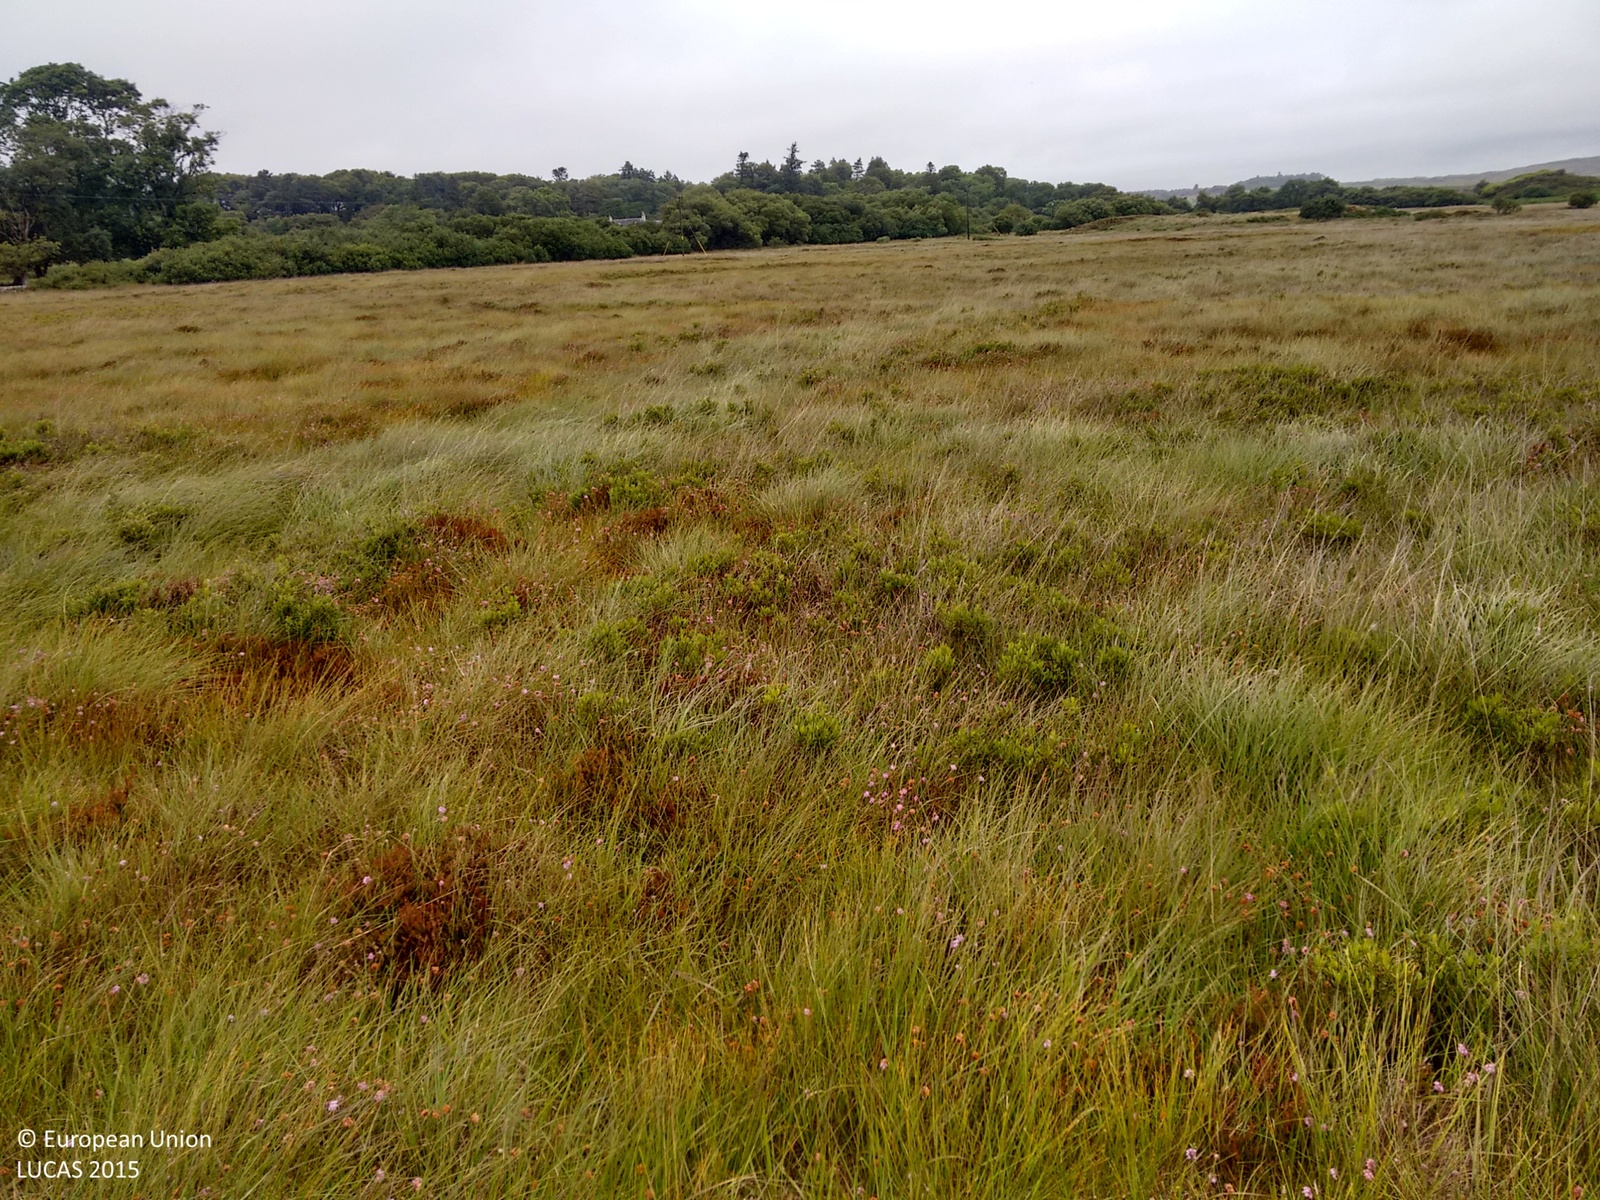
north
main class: Shrubland
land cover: Shrubland without tree cover
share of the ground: 50 - 75 %
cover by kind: shrubs 60 %, herbaceous plants 40 %
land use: Semi-natural and natural areas not in use
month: August
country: GB
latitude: 54.8478
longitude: -4.6358
